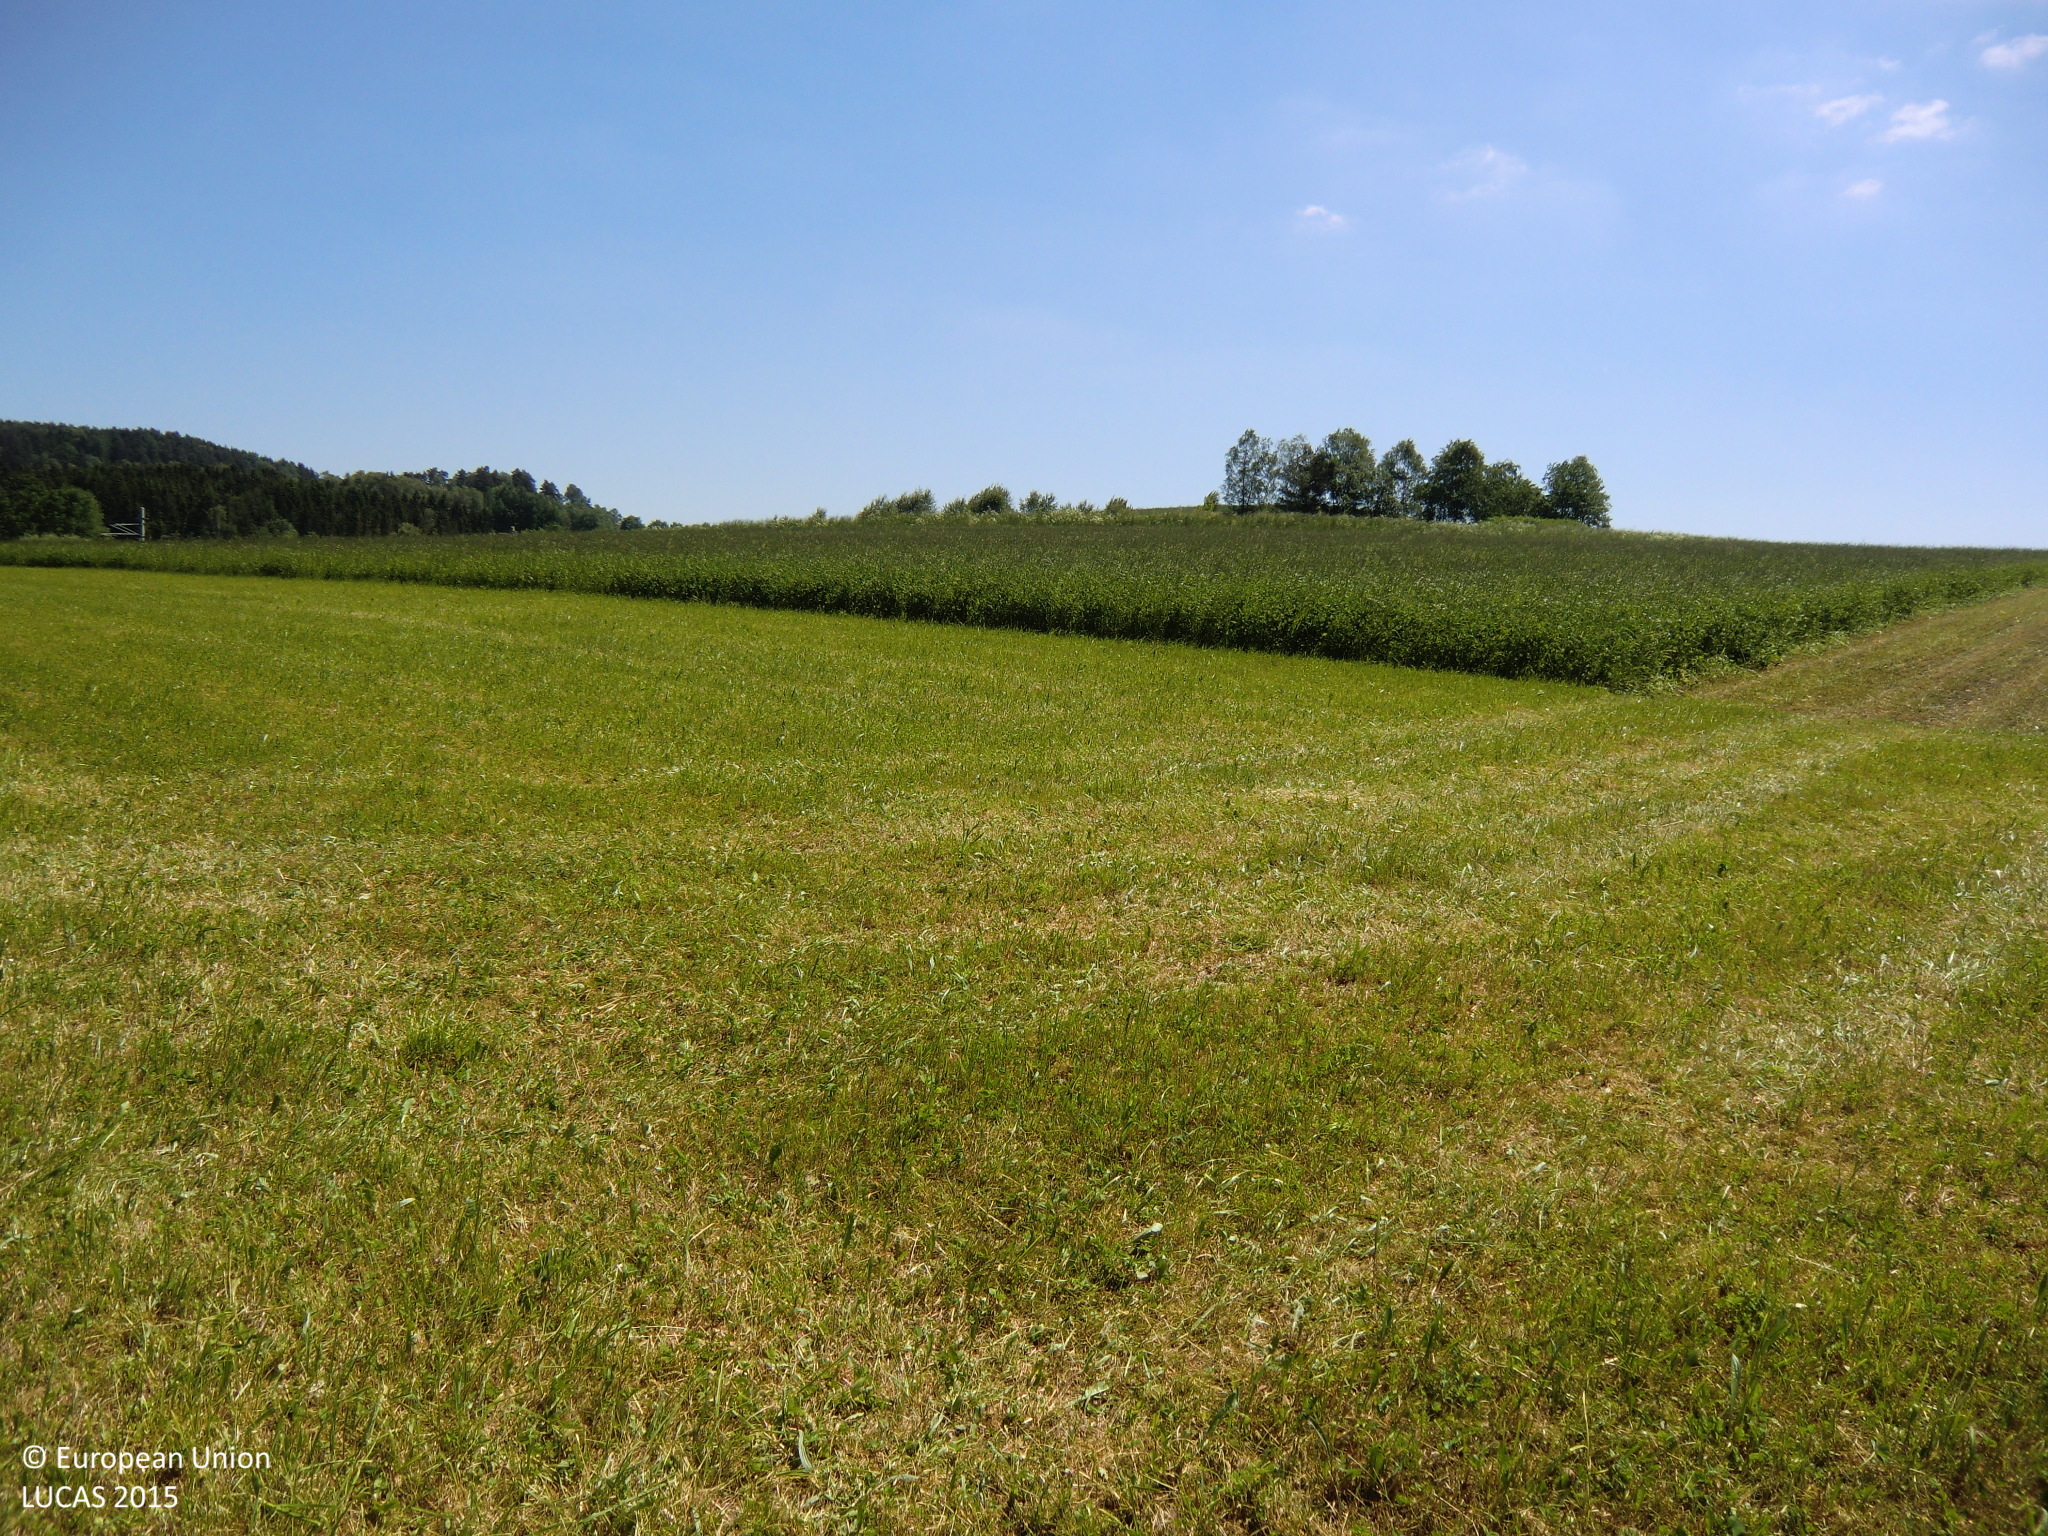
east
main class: Grassland
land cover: Grassland without tree/shrub cover
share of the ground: > 75 %
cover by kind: herbaceous plants 100 %
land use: Agriculture (excluding fallow land and kitchen gardens)
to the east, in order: Grassland without tree/shrub cover; Temporary grasslands; Shrubland with sparse tree cover; Railways; Electric lines; Grassland without tree/shrub cover; Rye
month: June
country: AT
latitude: 48.5849
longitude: 14.4336
